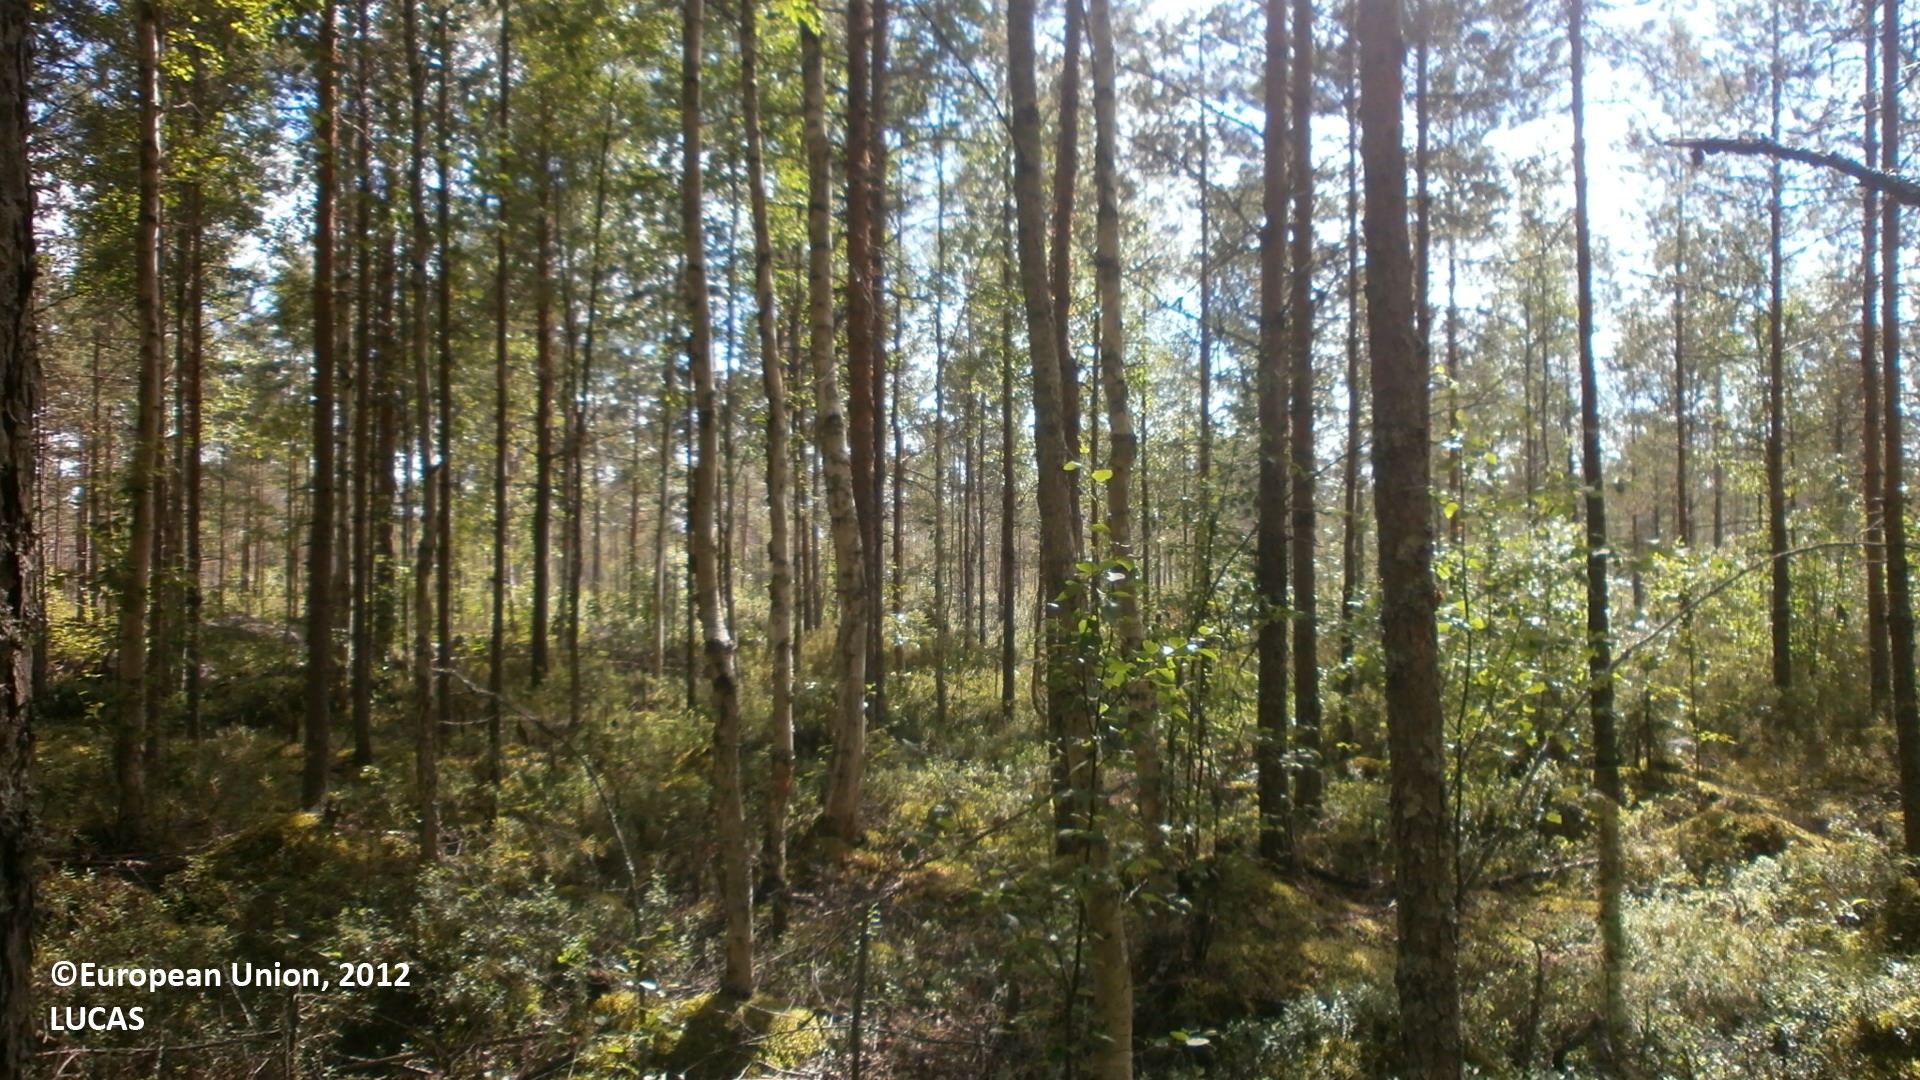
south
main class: Woodland
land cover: Pine dominated mixed woodland
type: boreal forest
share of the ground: 50 - 75 %
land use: Forestry
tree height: > 5 m
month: July
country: FI
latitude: 64.0063
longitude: 23.8671
